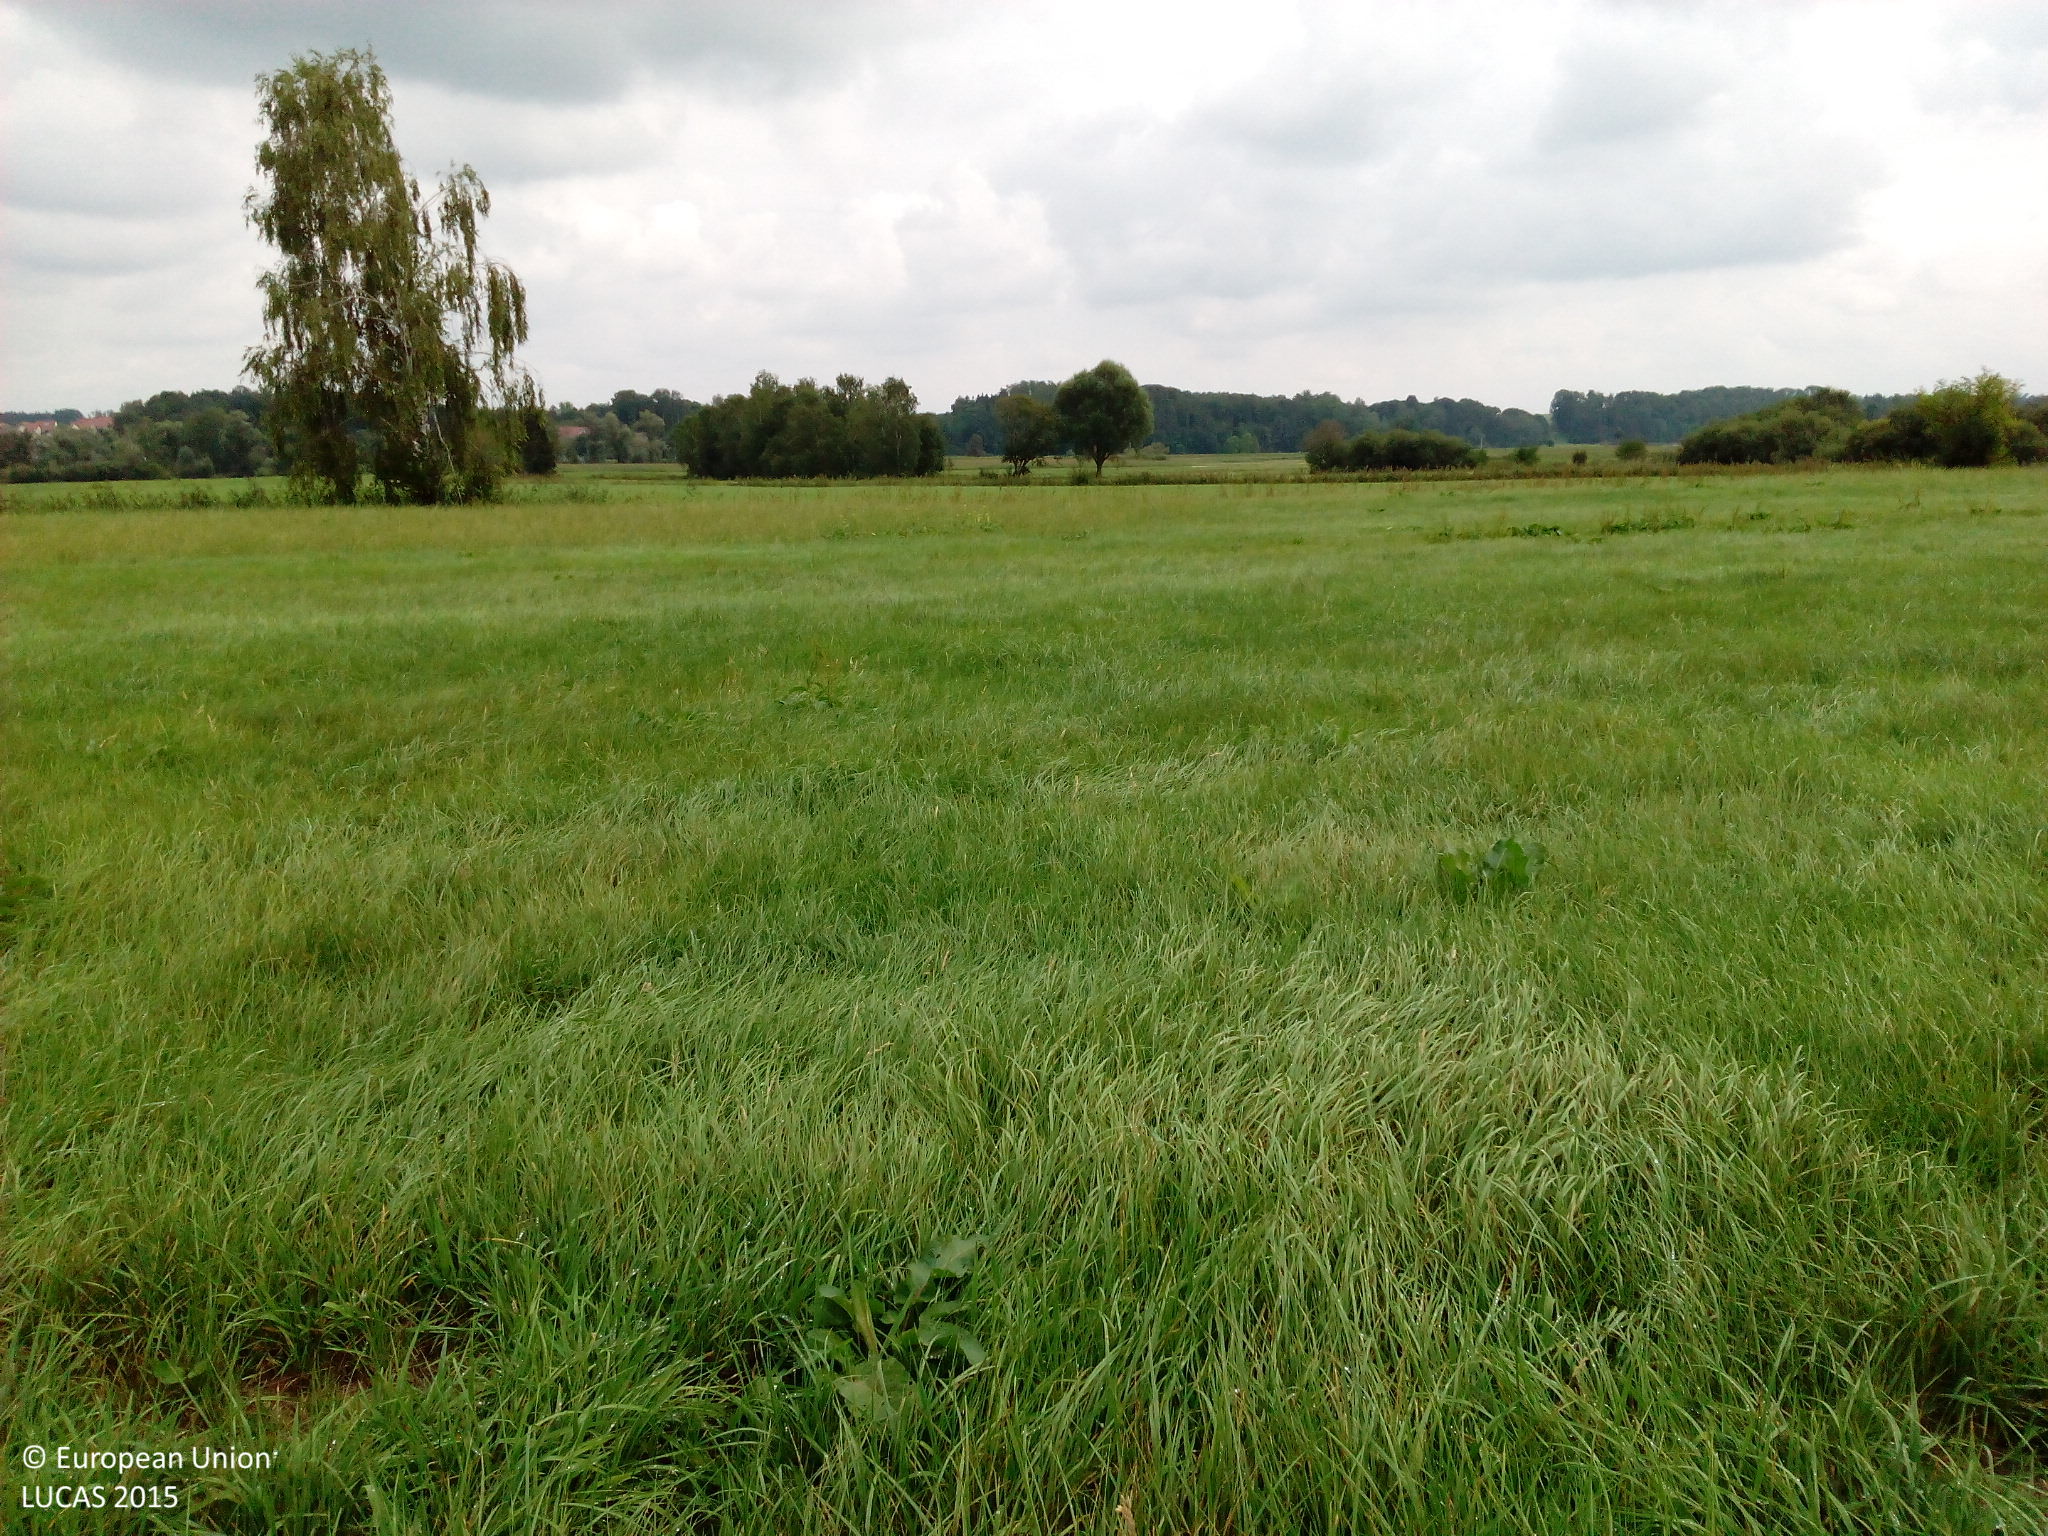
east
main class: Grassland
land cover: Grassland without tree/shrub cover
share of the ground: > 75 %
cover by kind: herbaceous plants 100 %
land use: Agriculture (excluding fallow land and kitchen gardens)
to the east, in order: Grassland without tree/shrub cover; Shruby margins; Rivers and streams; Shruby margins; Tracks; Grassland without tree/shrub cover; Shruby margins; Rivers and streams; Shruby margins; Grass margins; Tracks; Grassland without tree/shrub cover; Shruby margins; Rivers and streams; Broadleaved woodland; Shruby margins; Grass margins; Tracks; Grassland without tree/shrub cover; Spontaneously vegetated surfaces; Grassland without tree/shrub cover
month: September
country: DE
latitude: 48.3311
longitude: 10.3101
